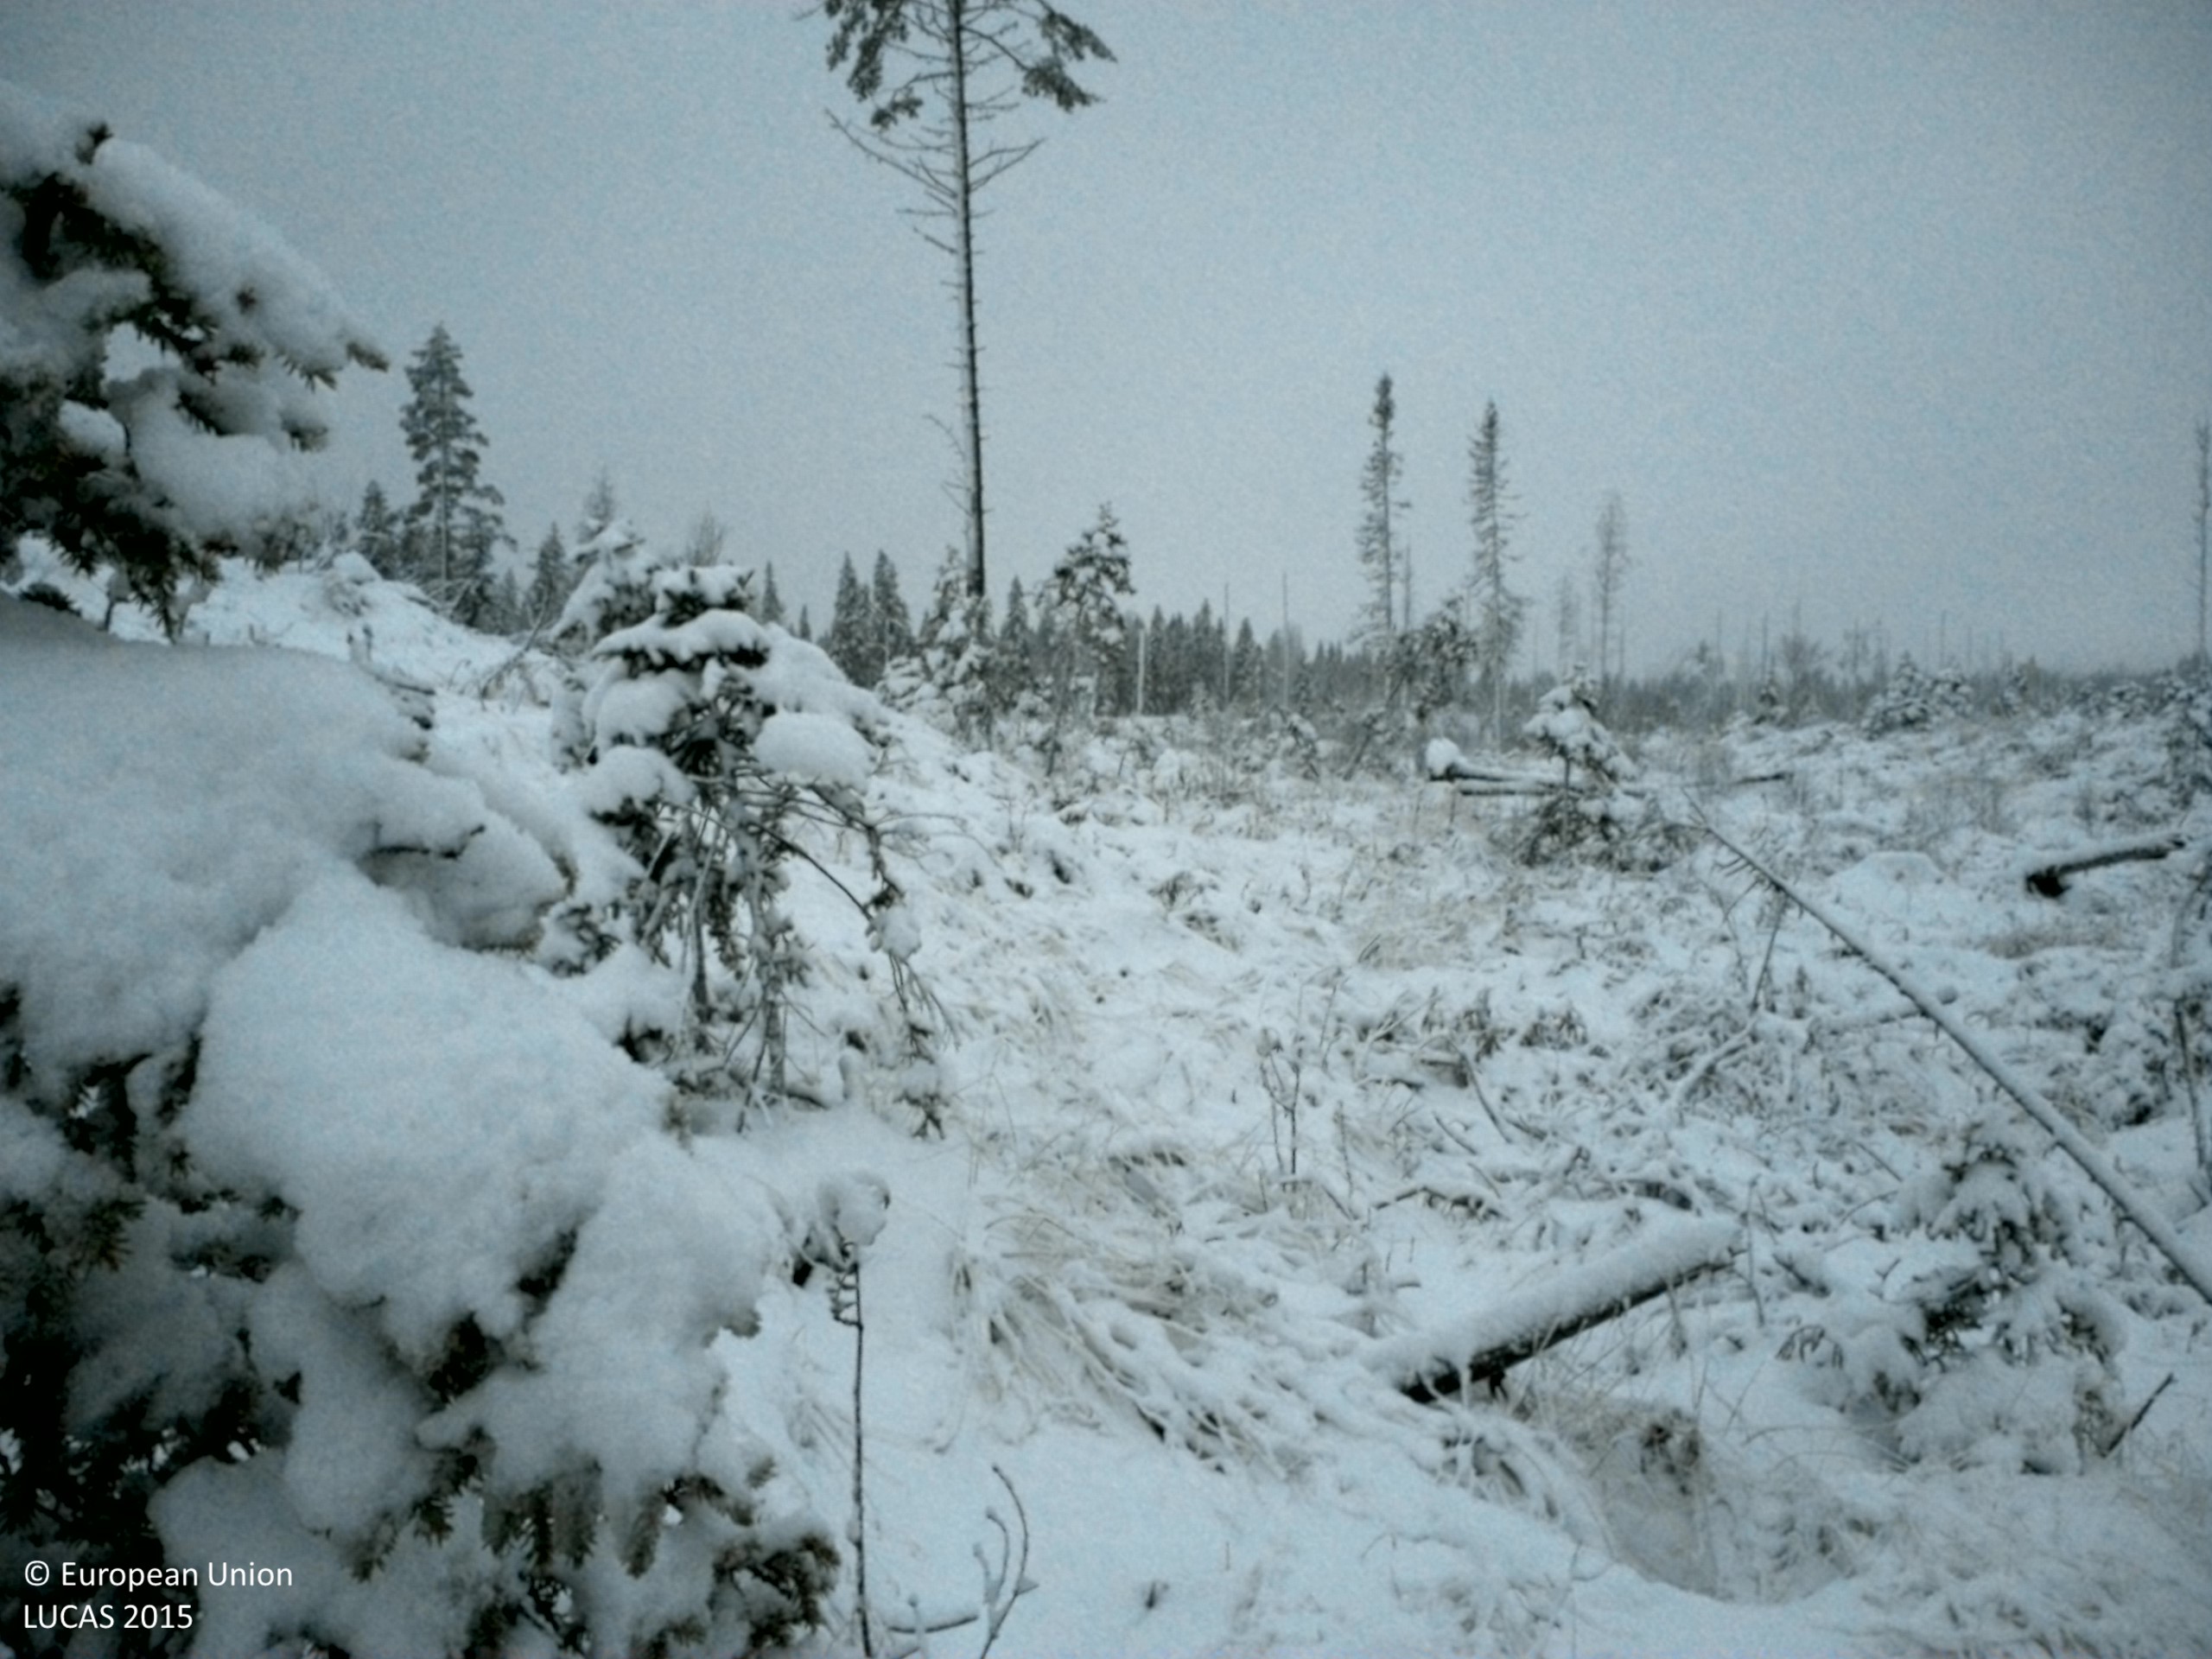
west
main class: Woodland
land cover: Spruce dominated mixed woodland
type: boreal forest
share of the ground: 10 - 25 %
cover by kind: herbaceous plants 55 %, lichens and mosses 20 %, coniferous forest trees 10 %, shrubs 10 %, broadleaved forest trees 5 %
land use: Forestry
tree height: < 5 m
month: November
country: SE
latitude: 63.6700
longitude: 15.9752
